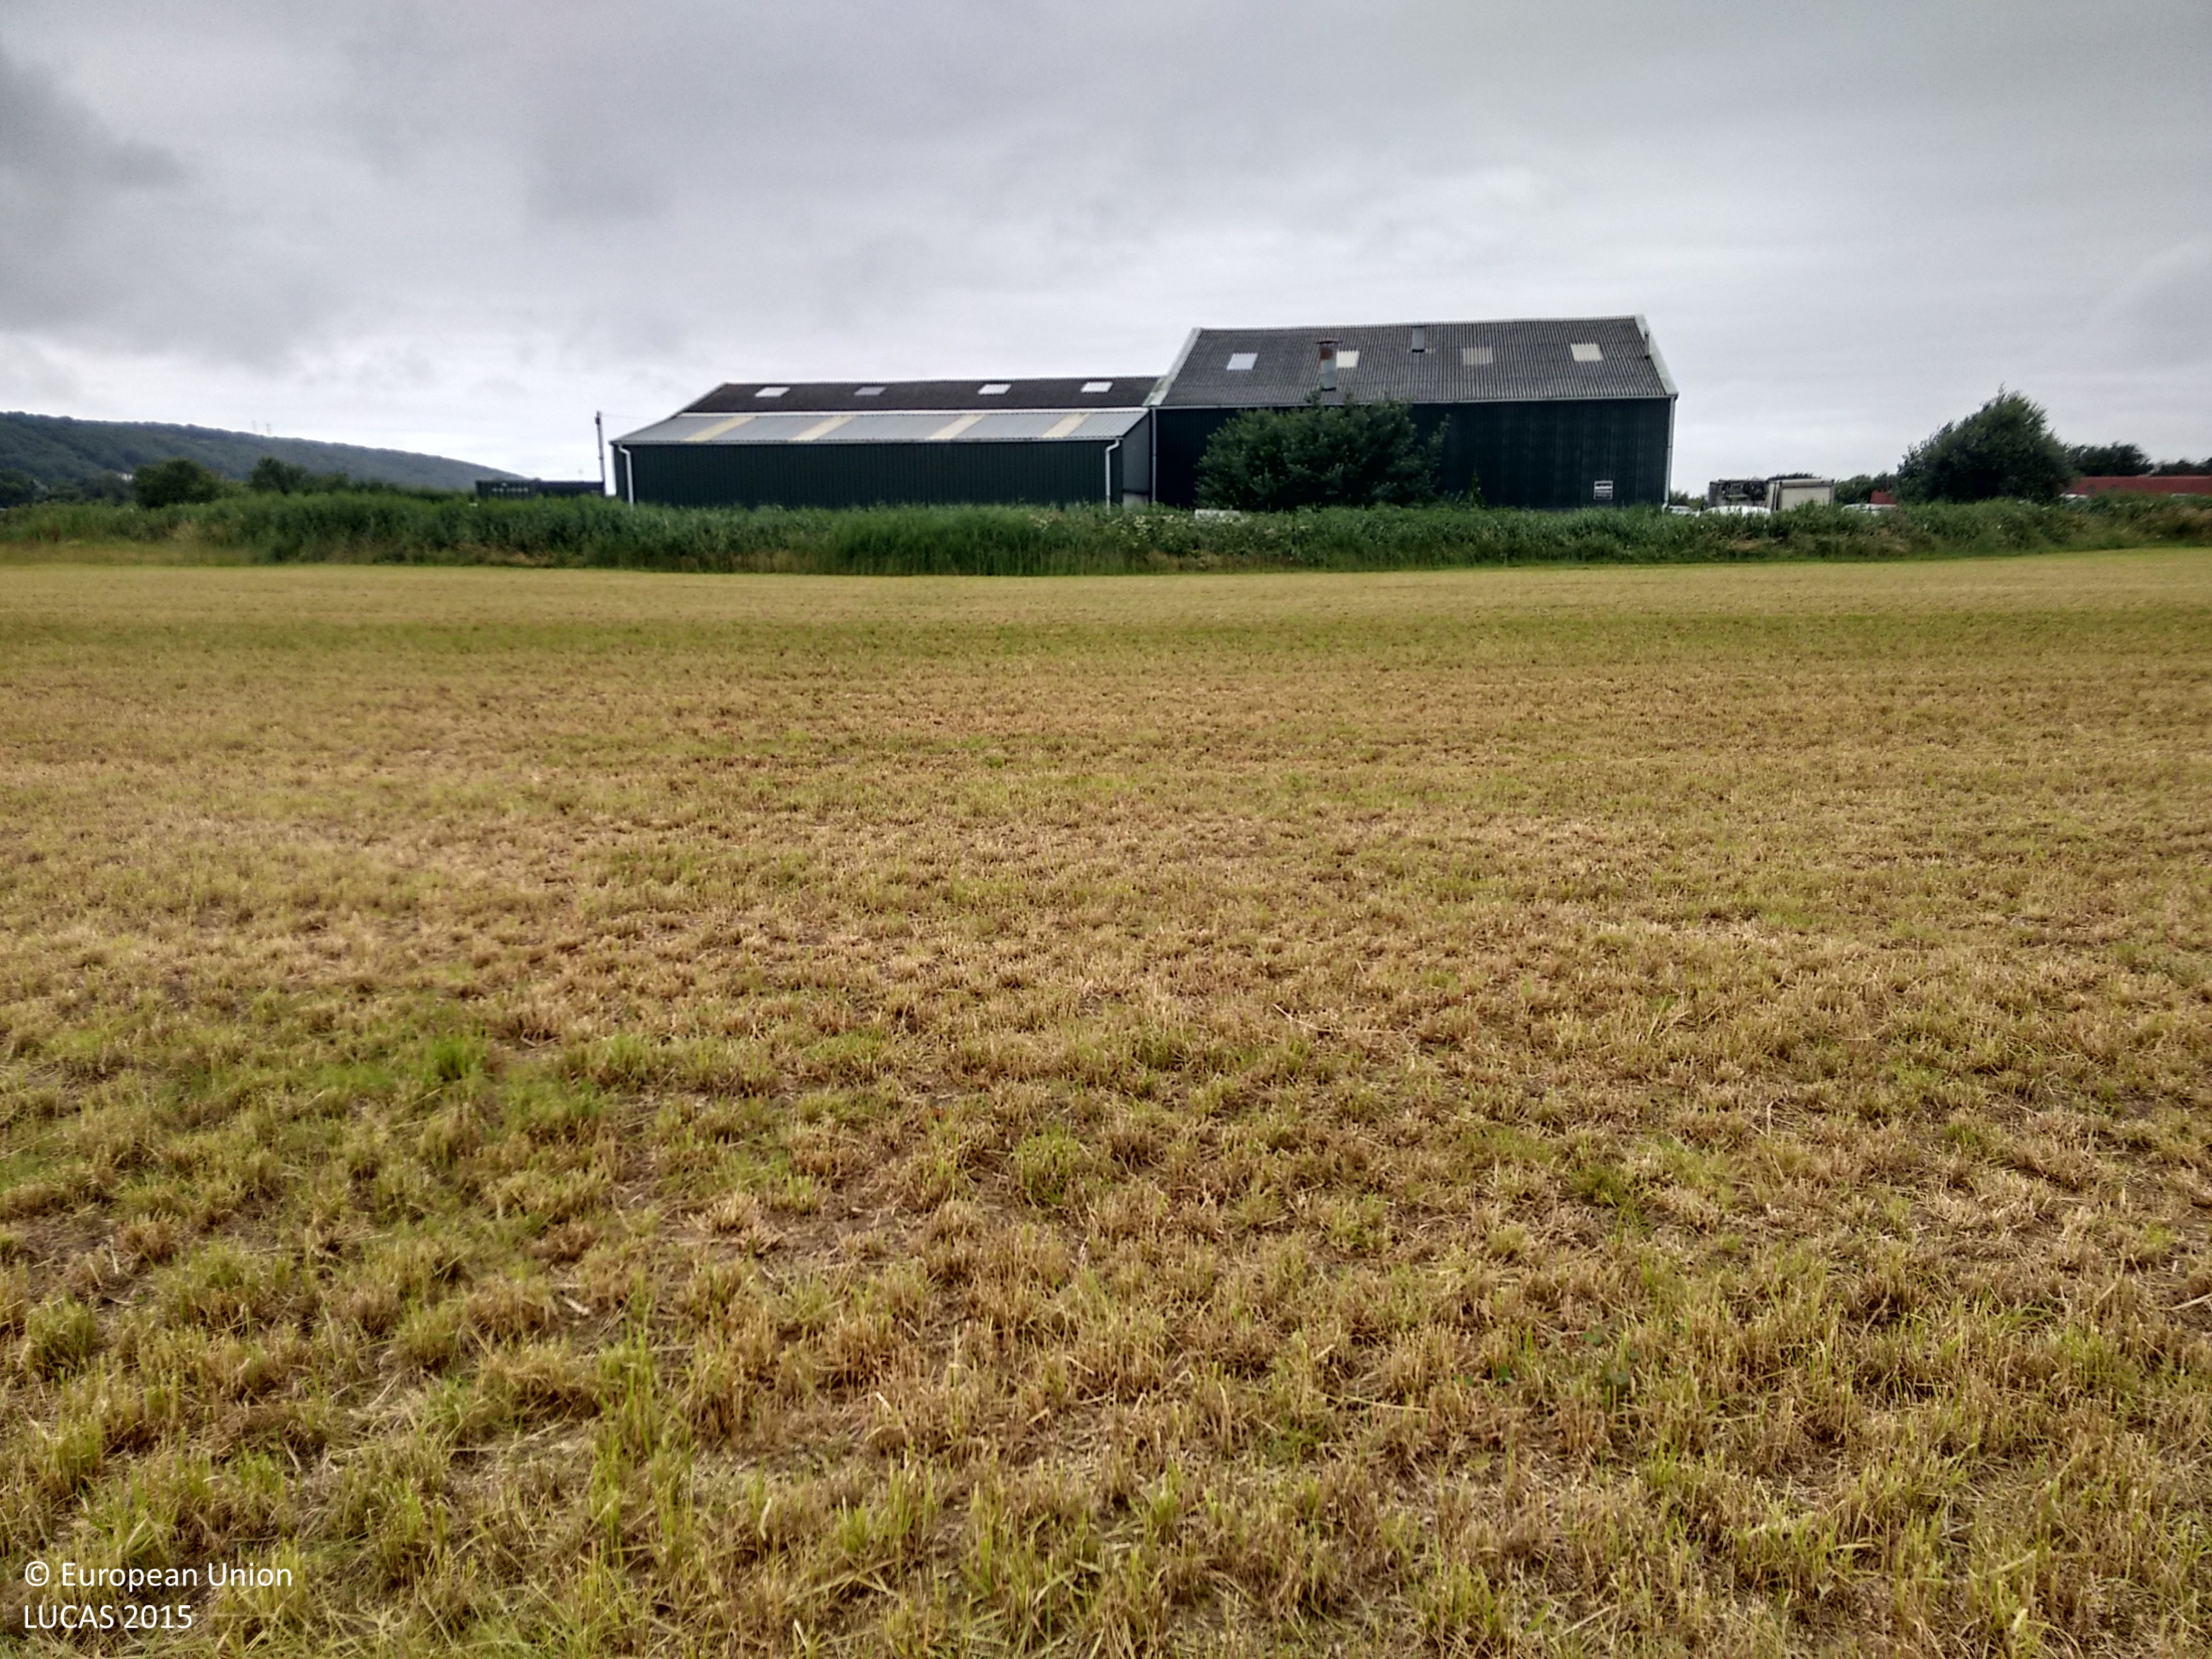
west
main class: Cropland
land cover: Temporary grasslands
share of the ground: 50 - 75 %
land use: Agriculture (excluding fallow land and kitchen gardens)
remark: Harvested field
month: July
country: GB
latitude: 51.3749
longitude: -2.9315
